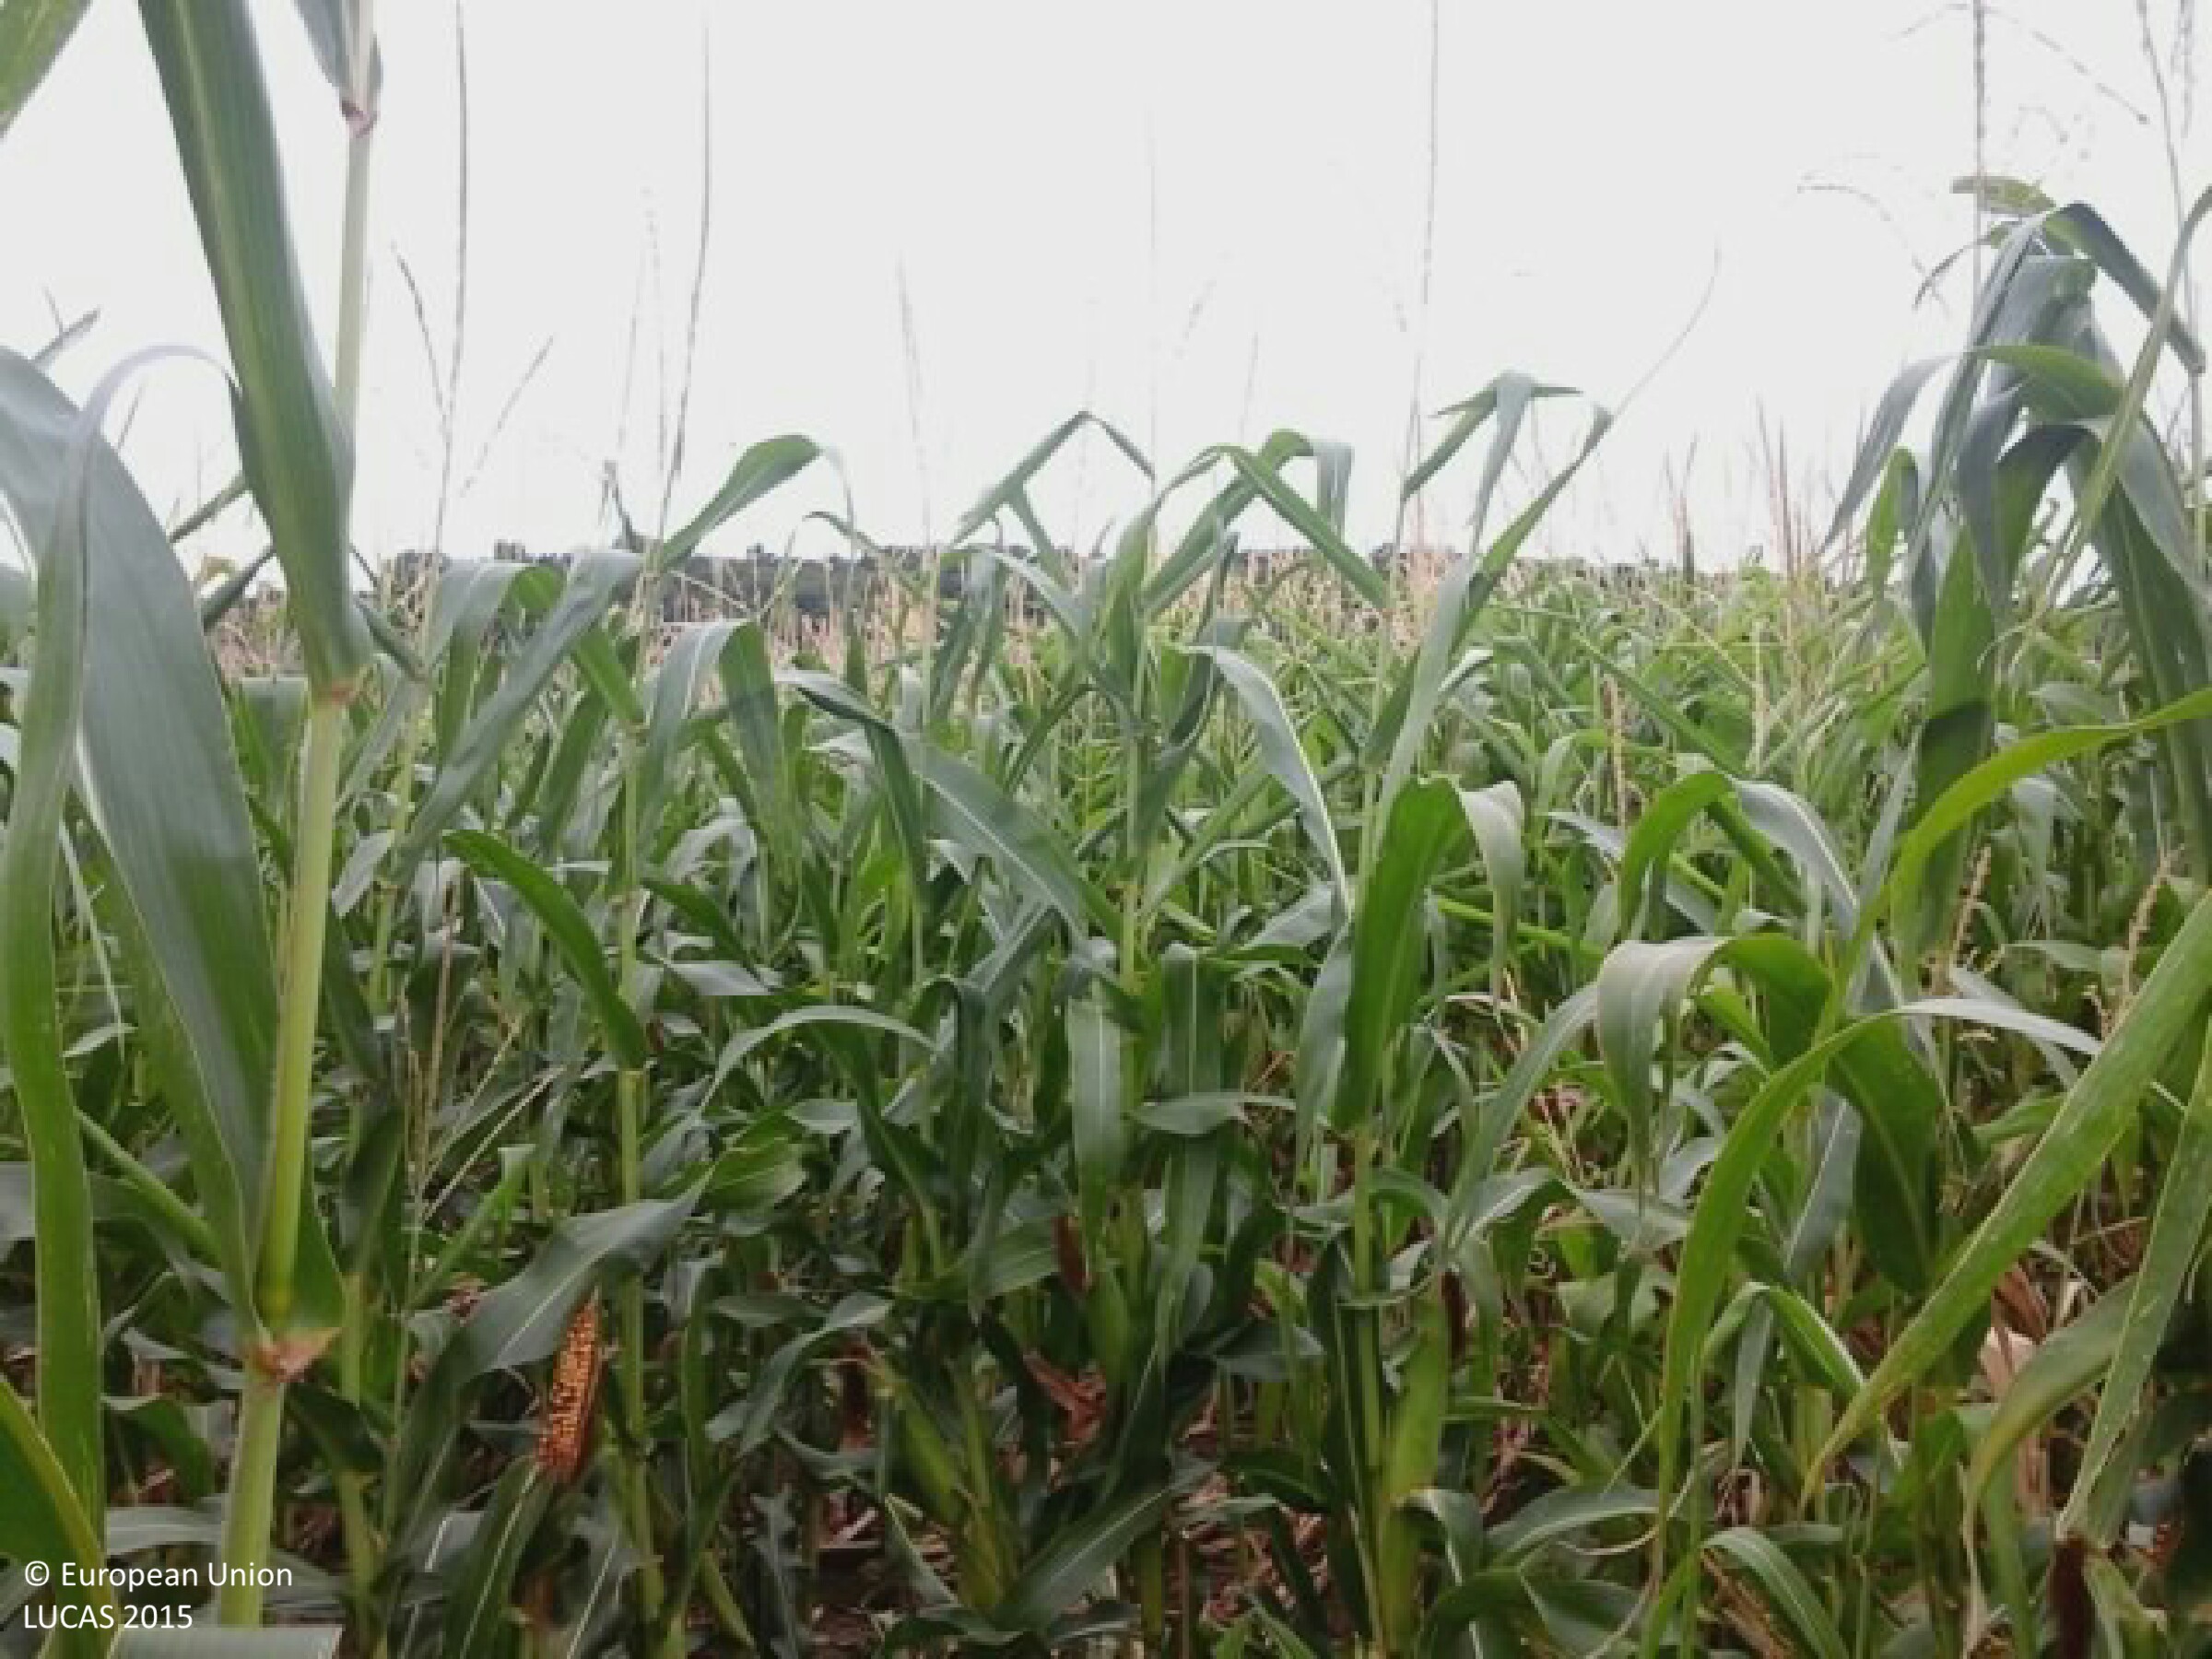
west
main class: Cropland
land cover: Maize
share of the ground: > 75 %
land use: Agriculture (excluding fallow land and kitchen gardens)
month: July
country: HU
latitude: 46.1483
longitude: 18.3850
